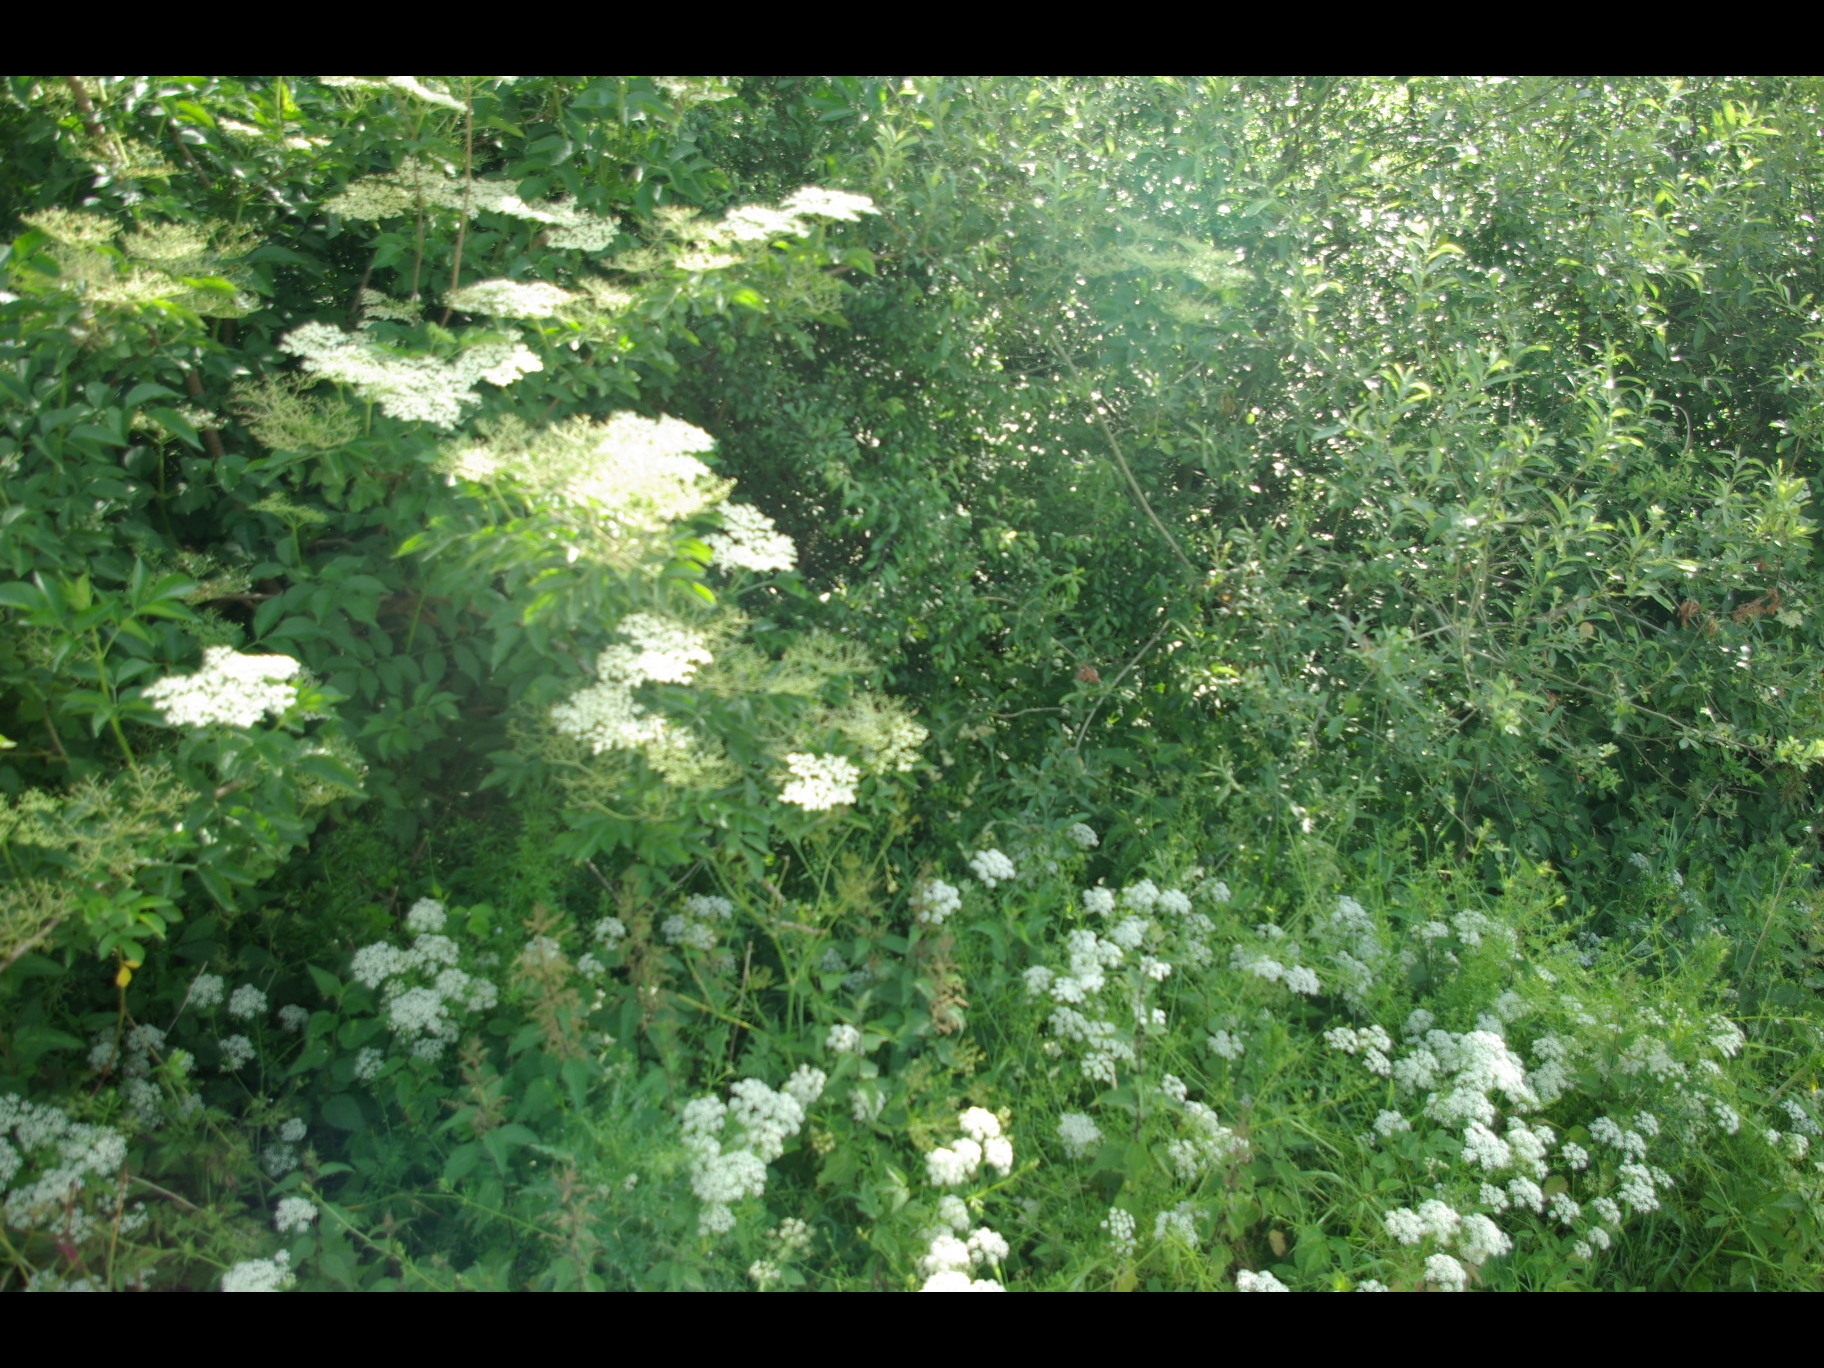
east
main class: Cropland
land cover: Maize
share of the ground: 10 - 25 %
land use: Agriculture (excluding fallow land and kitchen gardens)
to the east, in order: Maize; Shrubland without tree cover; Broadleaved woodland; Spontaneously vegetated surfaces; Other bare soil; Fences; Broadleaved woodland; Fences; Spontaneously vegetated surfaces; Artificial constructions in urban areas; Spontaneously vegetated surfaces; Fences; Broadleaved woodland; Tracks; Broadleaved woodland
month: June
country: DE
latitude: 54.2466
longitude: 9.8926
